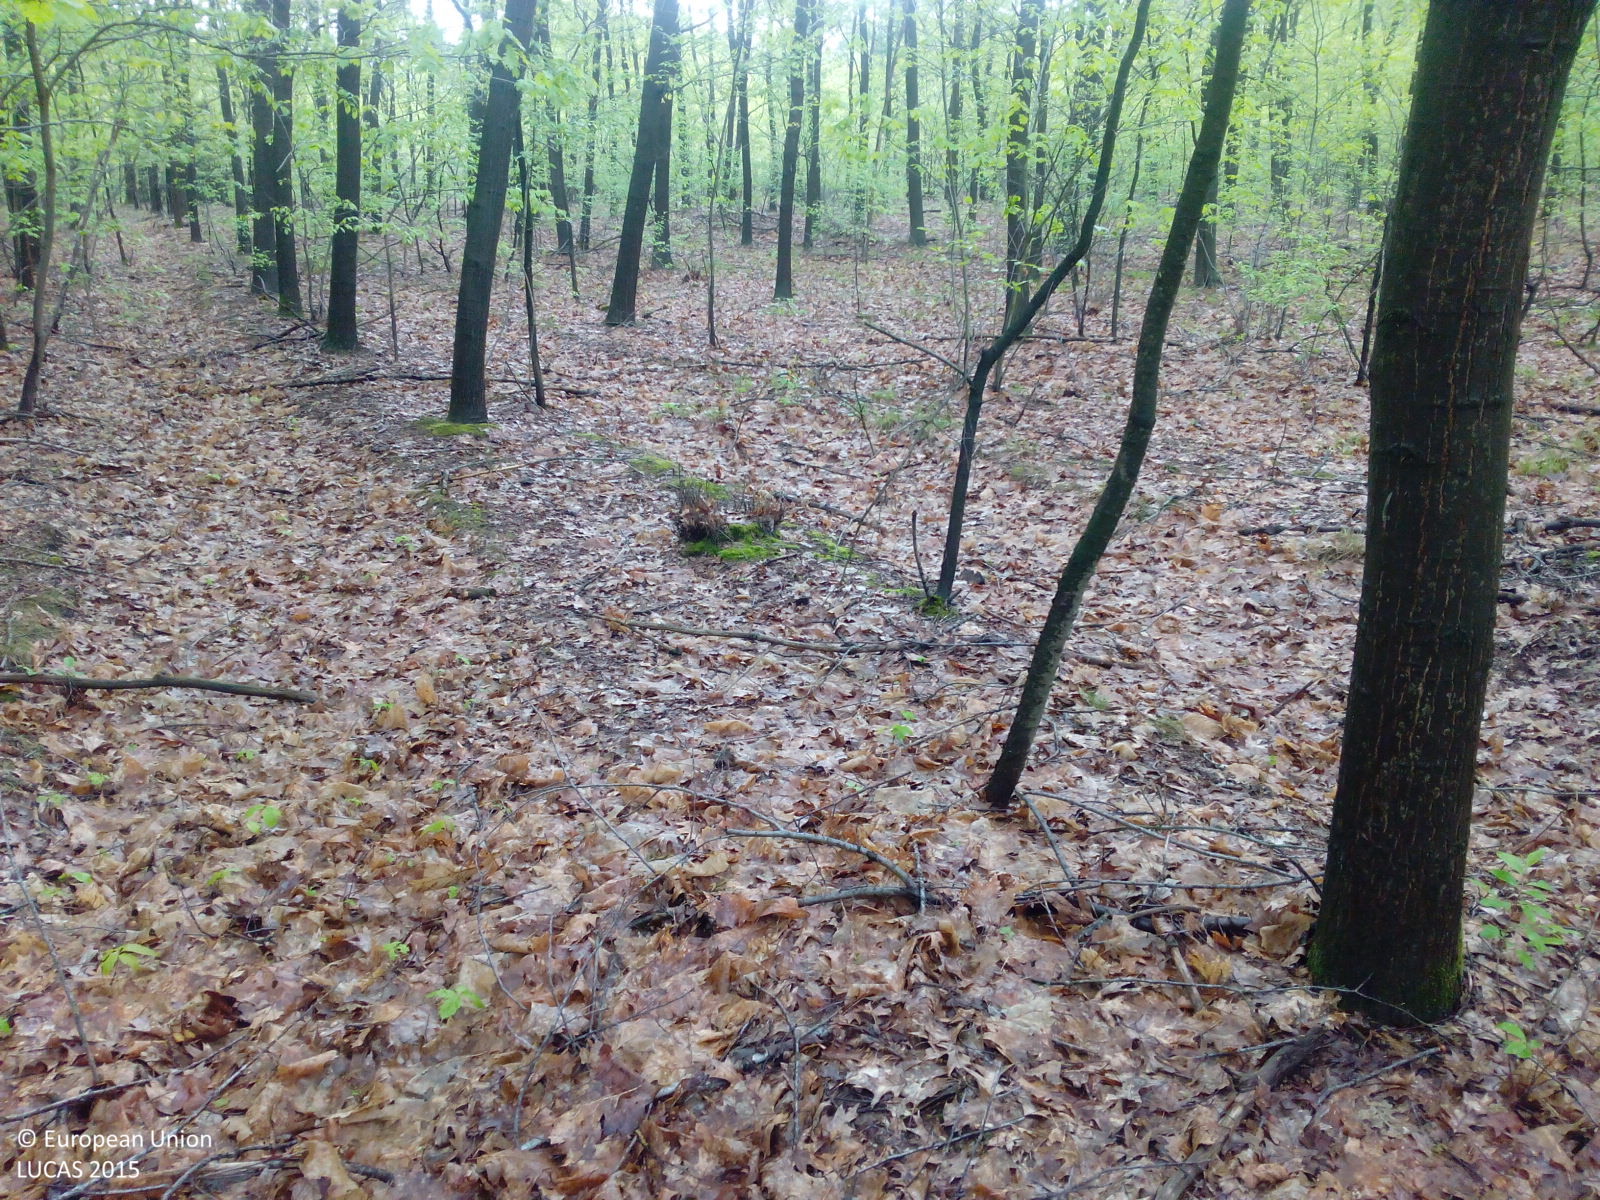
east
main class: Woodland
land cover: Broadleaved woodland
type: mesophytic deciduous forest
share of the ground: > 75 %
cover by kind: broadleaved forest trees 100 %
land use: Amenities, museums, leisure
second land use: Sport
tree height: > 5 m
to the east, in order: Broadleaved woodland; Tracks; Broadleaved woodland; Pine dominated mixed woodland; Tracks; Pine dominated mixed woodland; Ditches and canals; Broadleaved woodland
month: May
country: NL
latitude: 51.4132
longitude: 5.5842
